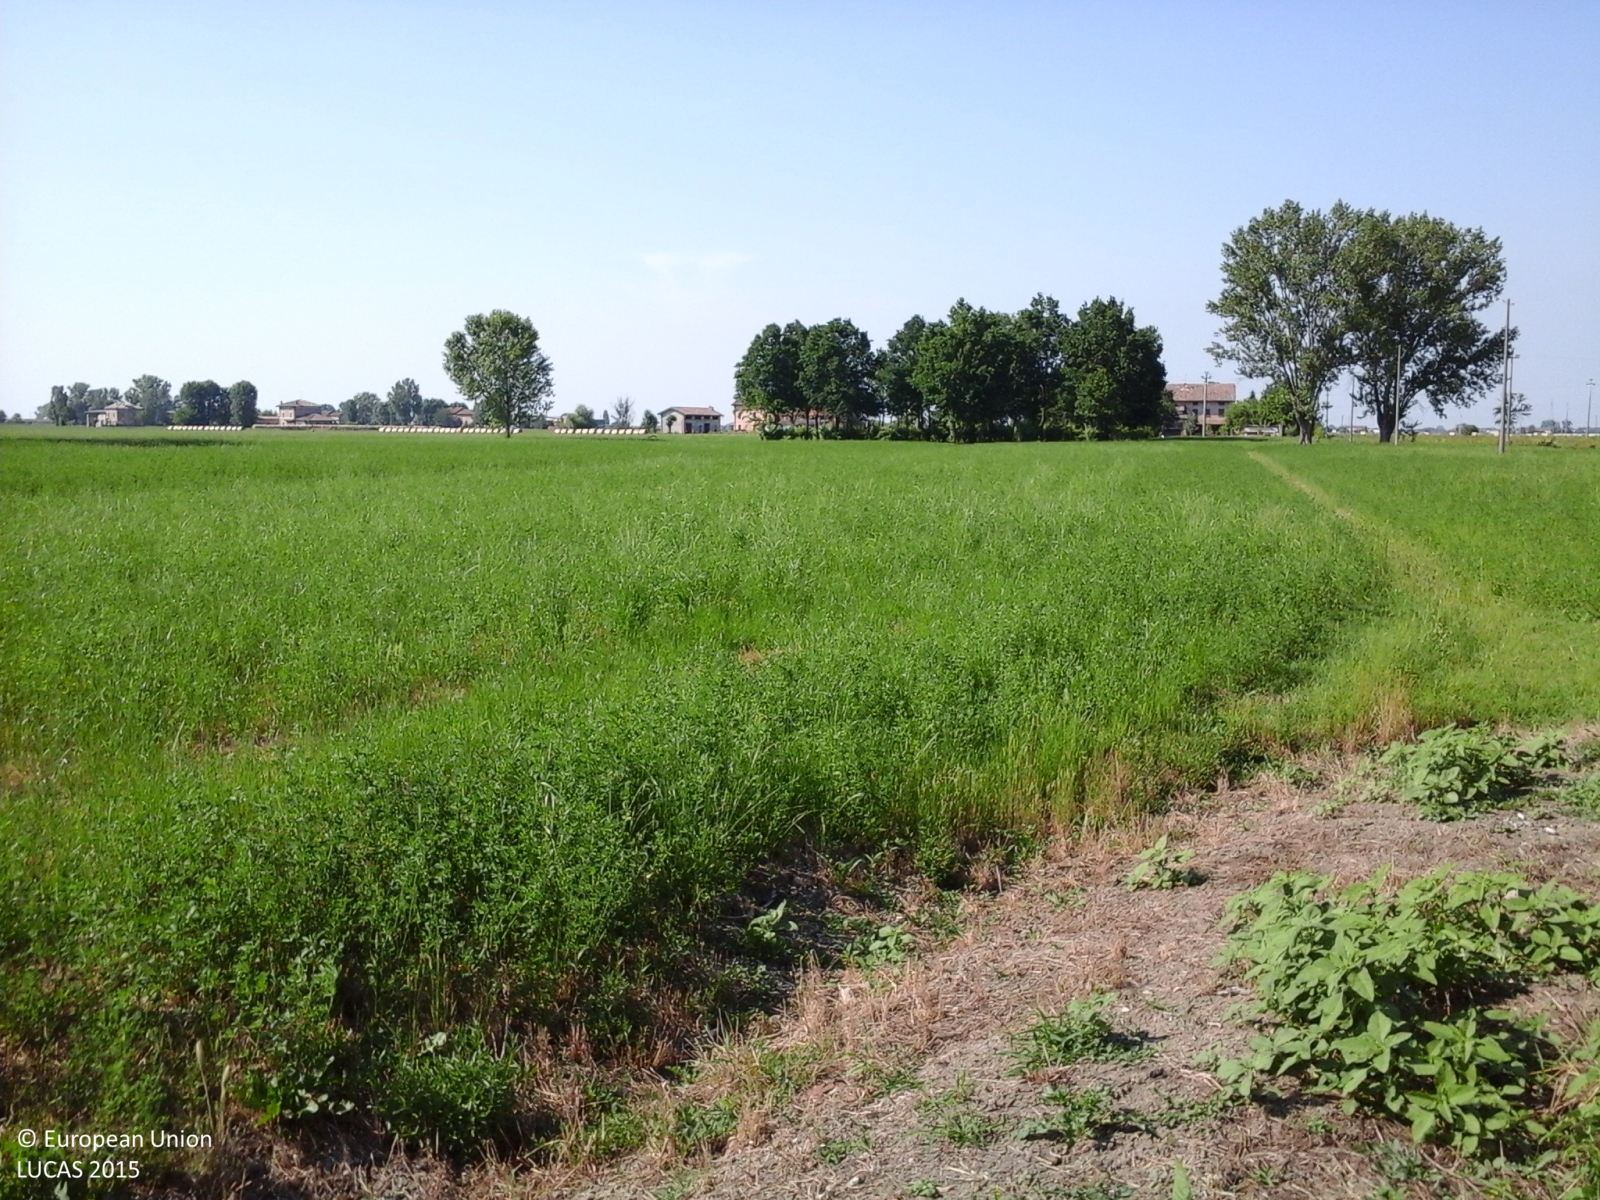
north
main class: Grassland
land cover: Spontaneously vegetated surfaces
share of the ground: 50 - 75 %
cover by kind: herbaceous plants 50 %, unconsolidated bare surface 50 %
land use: Agriculture (excluding fallow land and kitchen gardens)
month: June
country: IT
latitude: 44.9274
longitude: 10.1897
